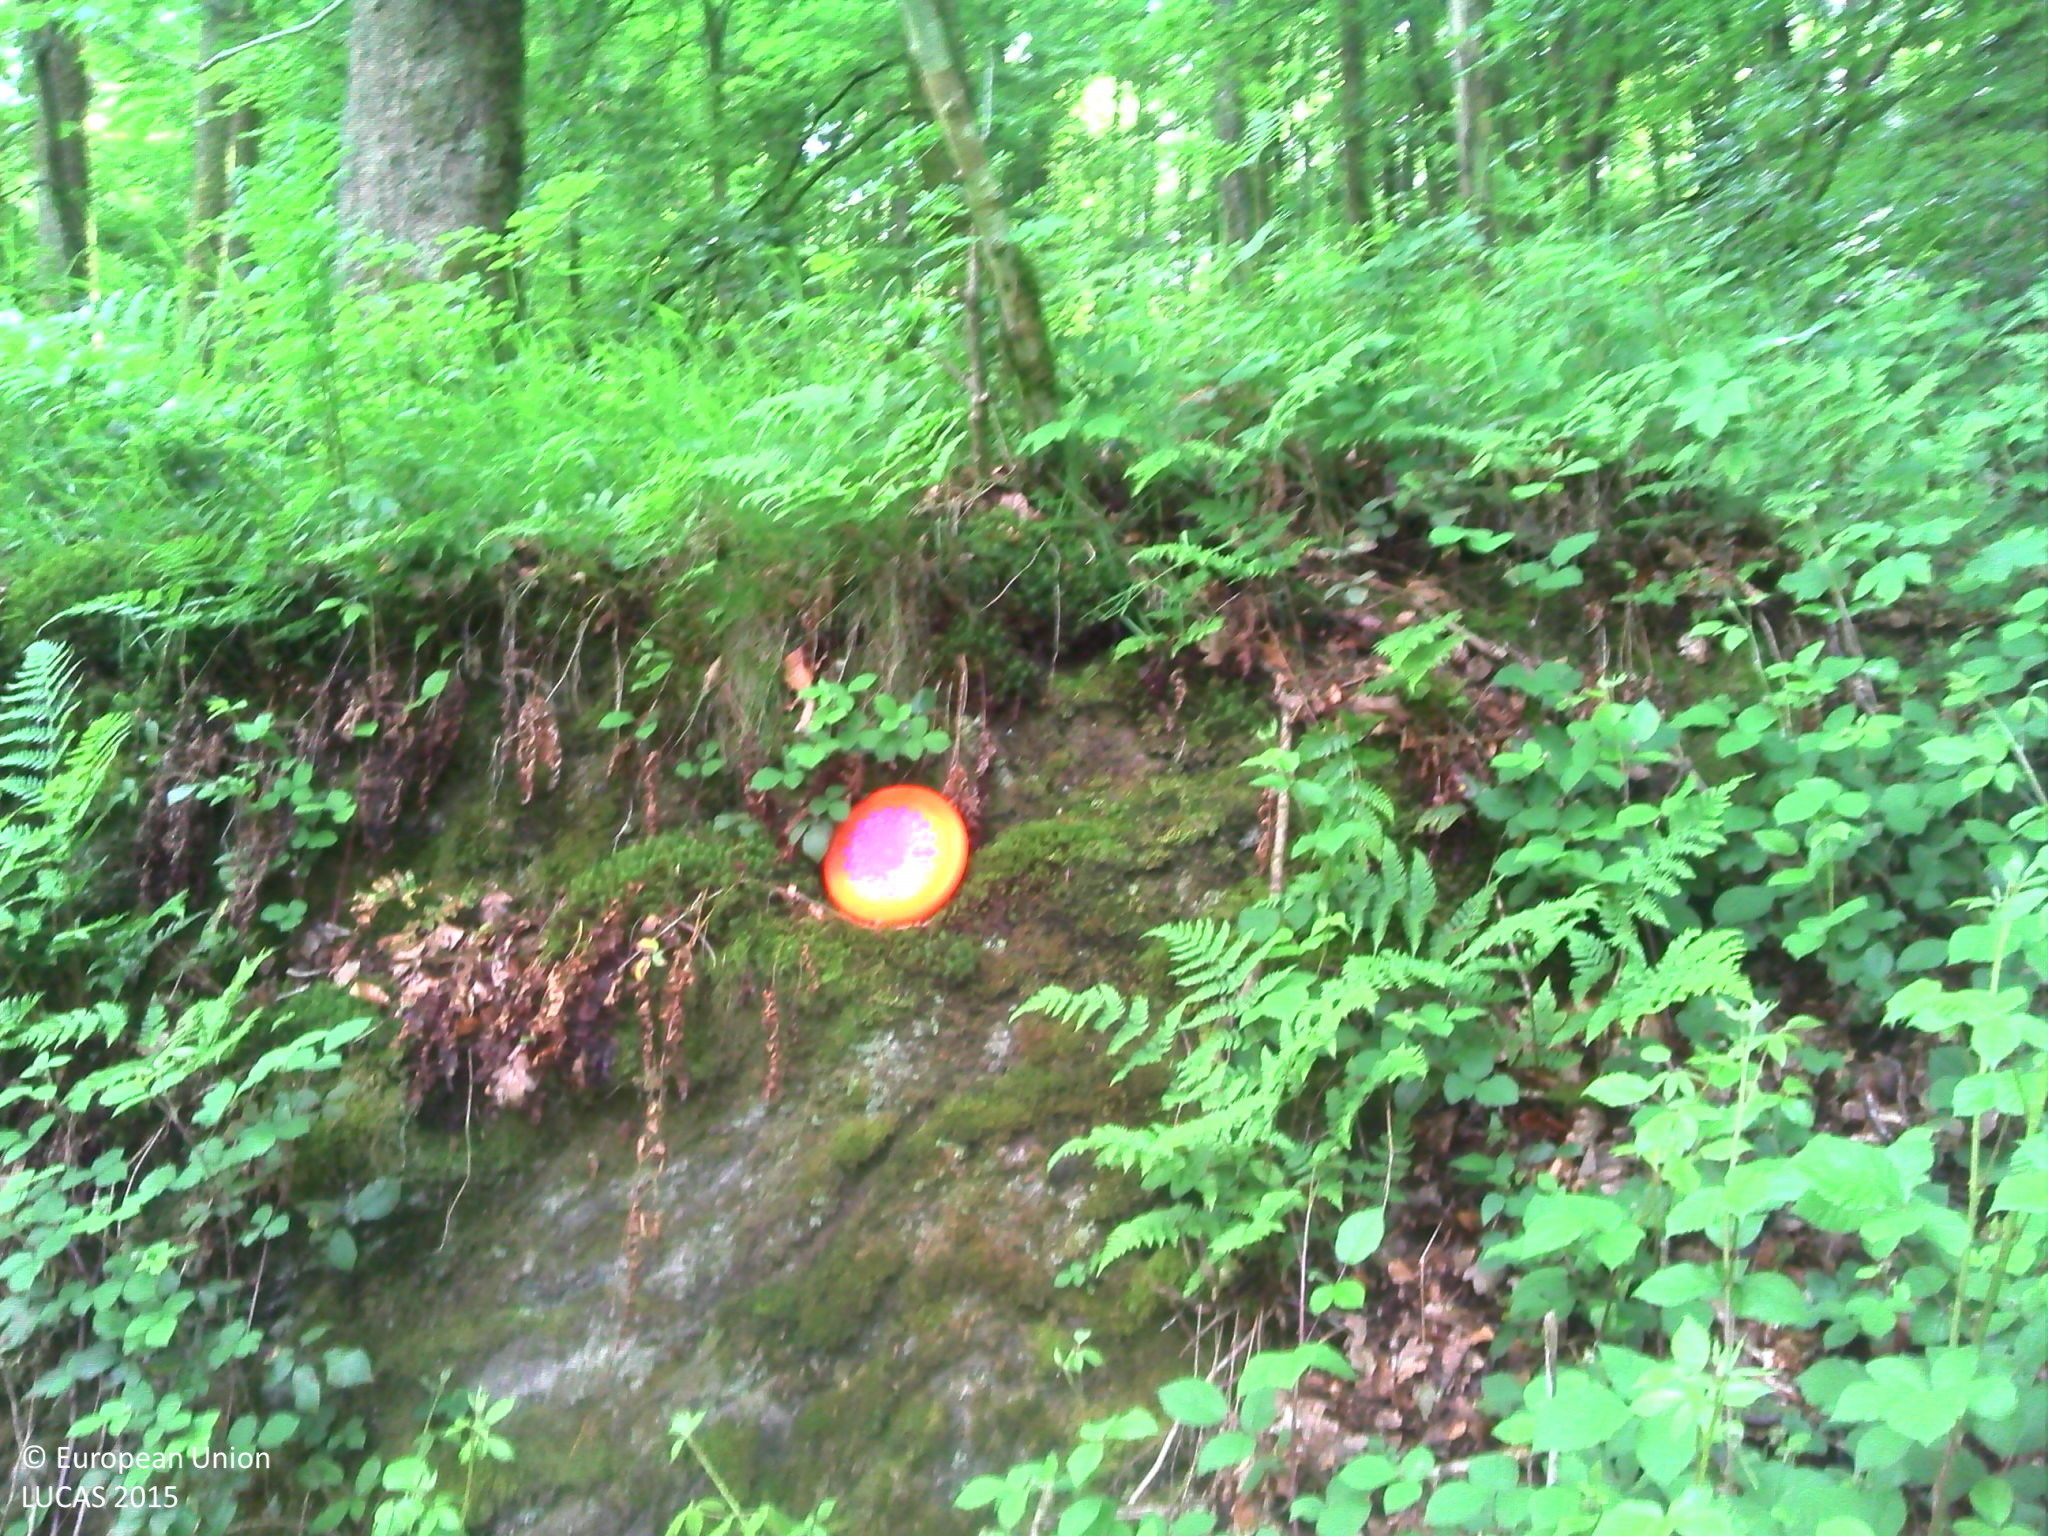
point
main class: Woodland
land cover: Broadleaved woodland
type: acidophilous oak and oak-birch forest
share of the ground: > 75 %
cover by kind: broadleaved forest trees 95 %, herbaceous plants 5 %
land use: Forestry
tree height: > 5 m
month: June
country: BE
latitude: 49.8895
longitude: 4.8888
